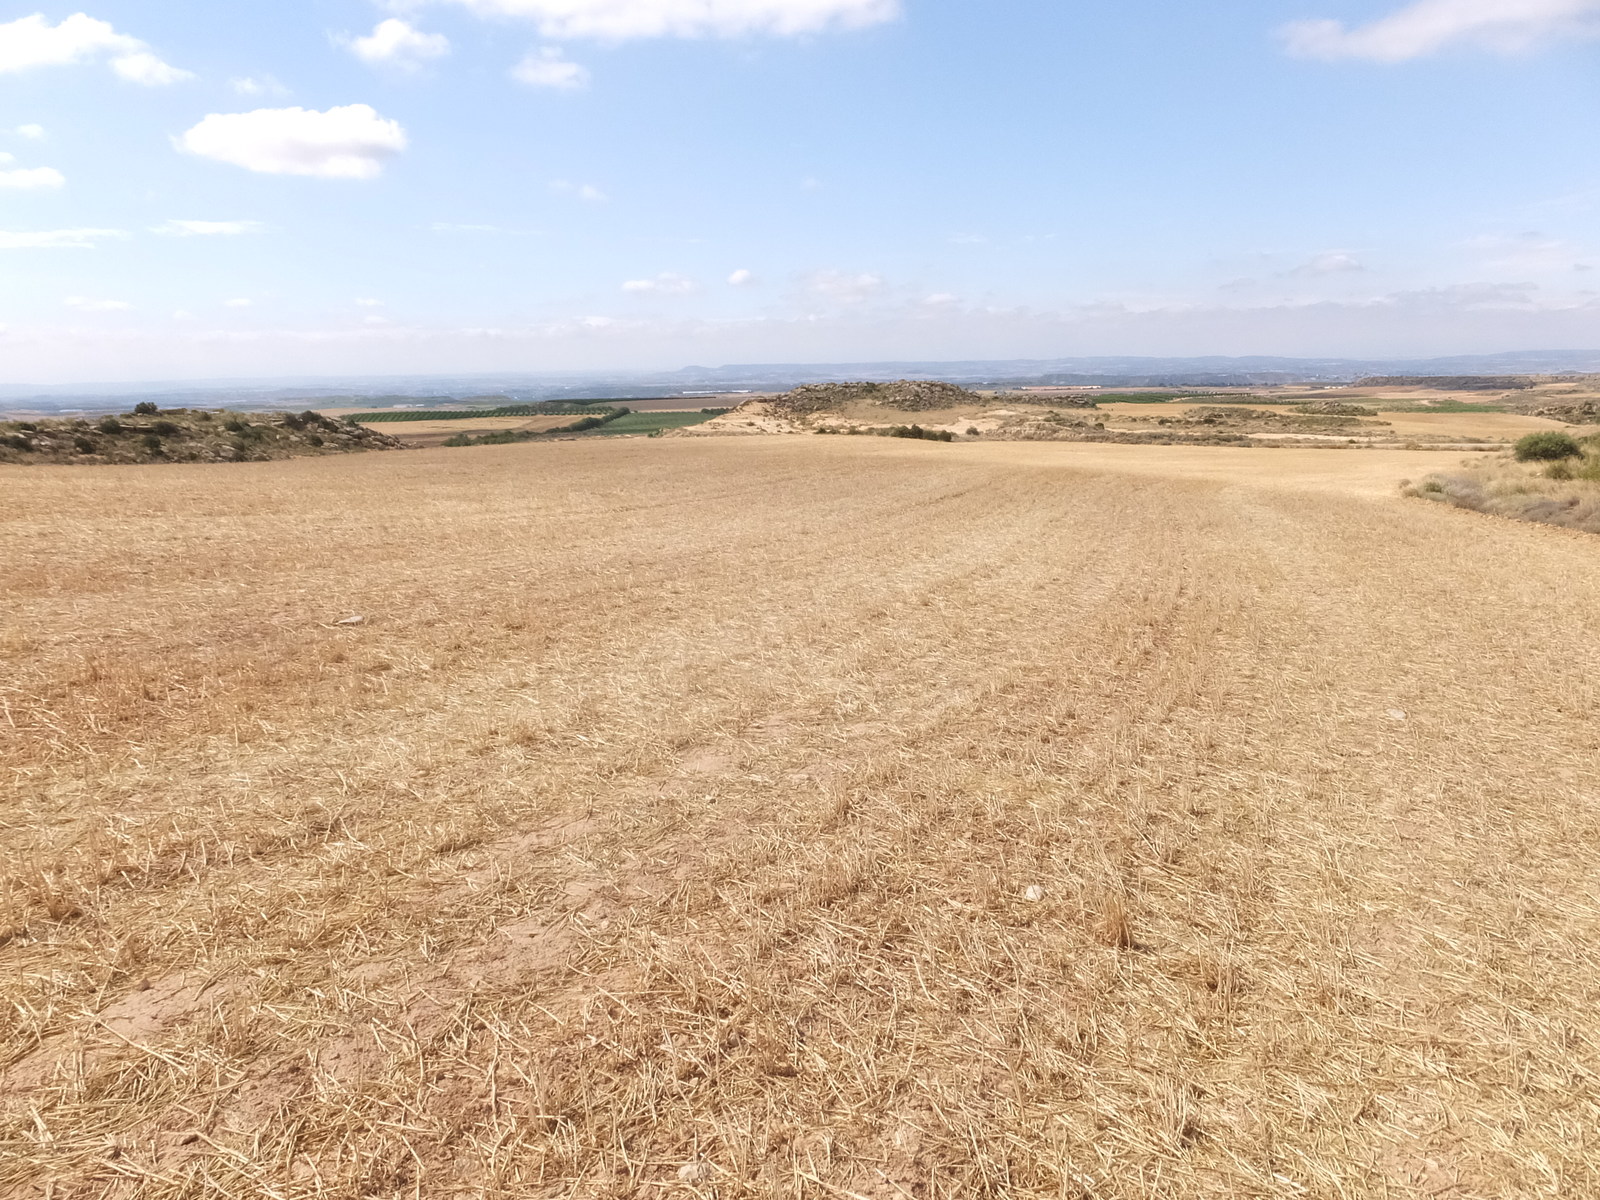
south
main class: Cropland
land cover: Barley
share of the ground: < 10 %
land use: Agriculture (excluding fallow land and kitchen gardens)
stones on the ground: < 10 %
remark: Harvested field
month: June
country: ES
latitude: 41.3306
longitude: -0.0861
